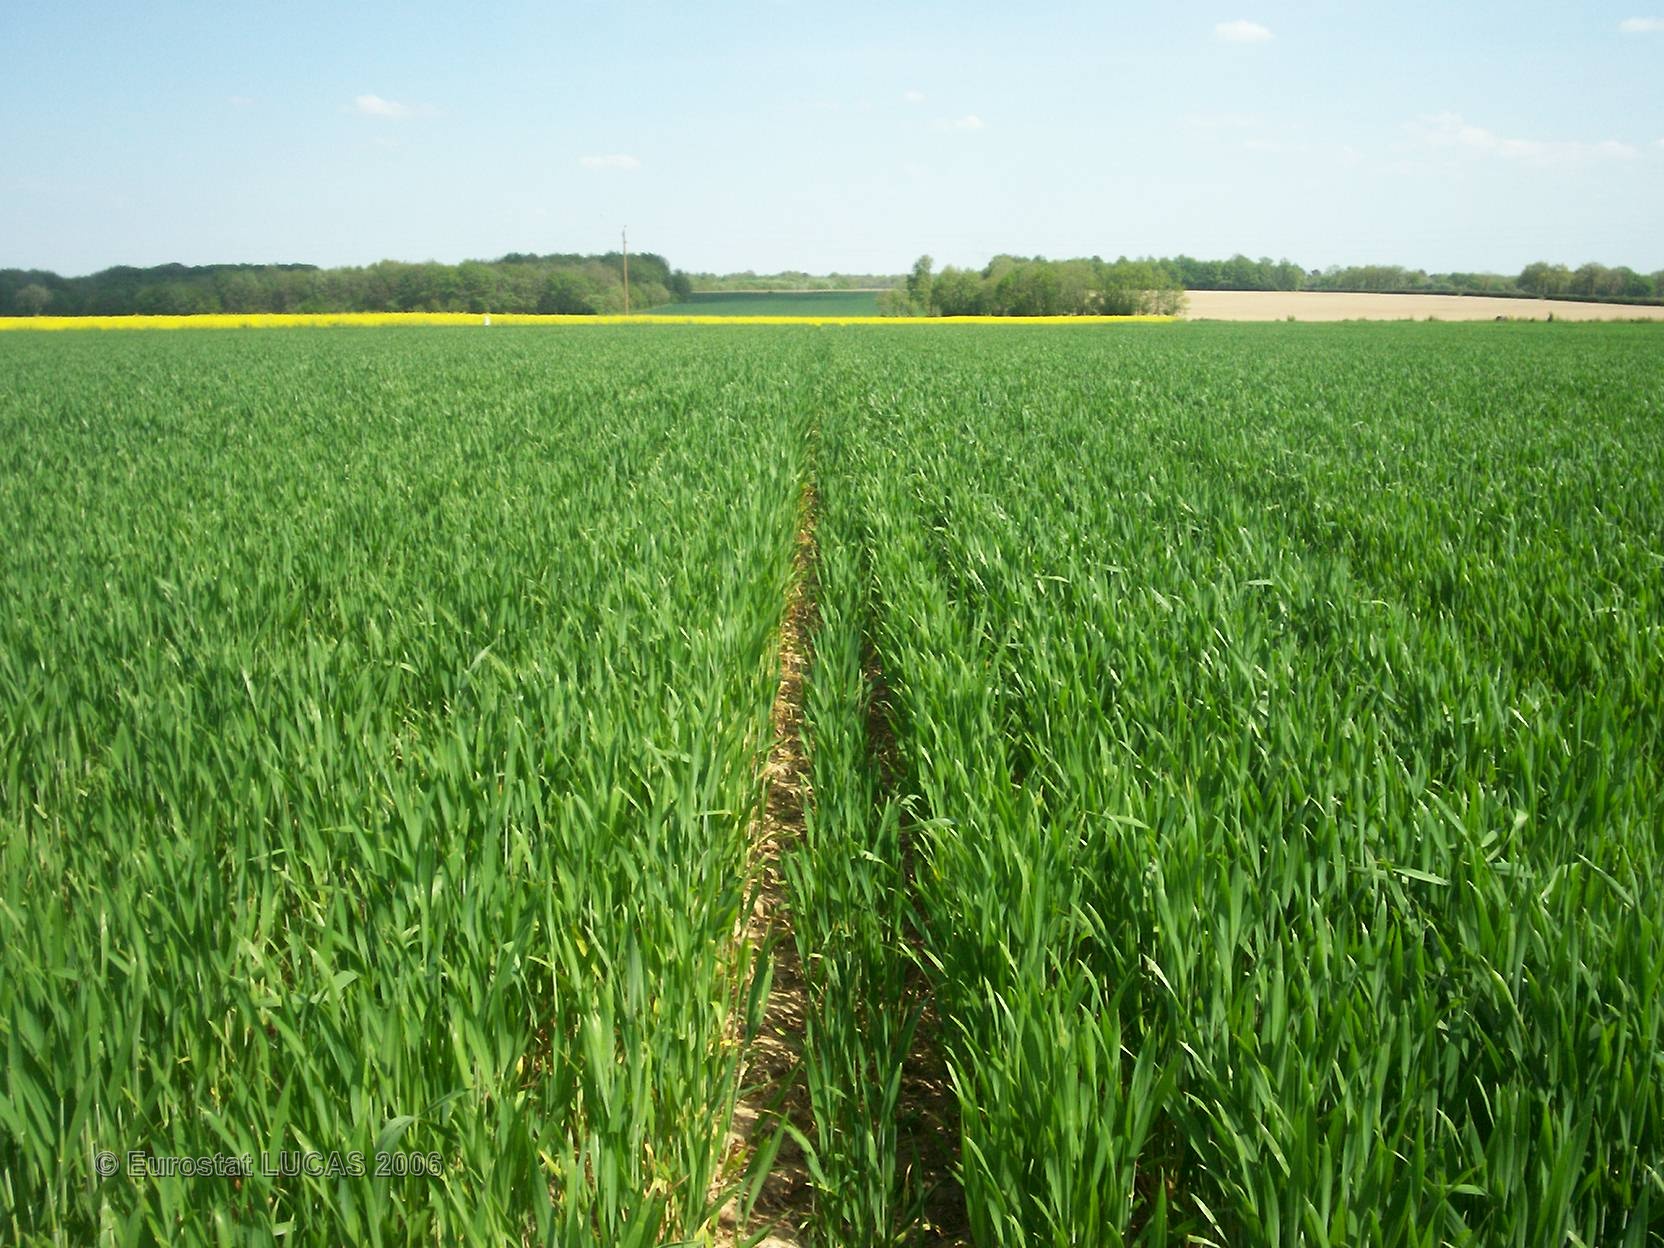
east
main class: Cropland
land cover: Common wheat
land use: Agriculture (excluding fallow land and kitchen gardens)
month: May
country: FR
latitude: 46.5061
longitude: 0.4823
